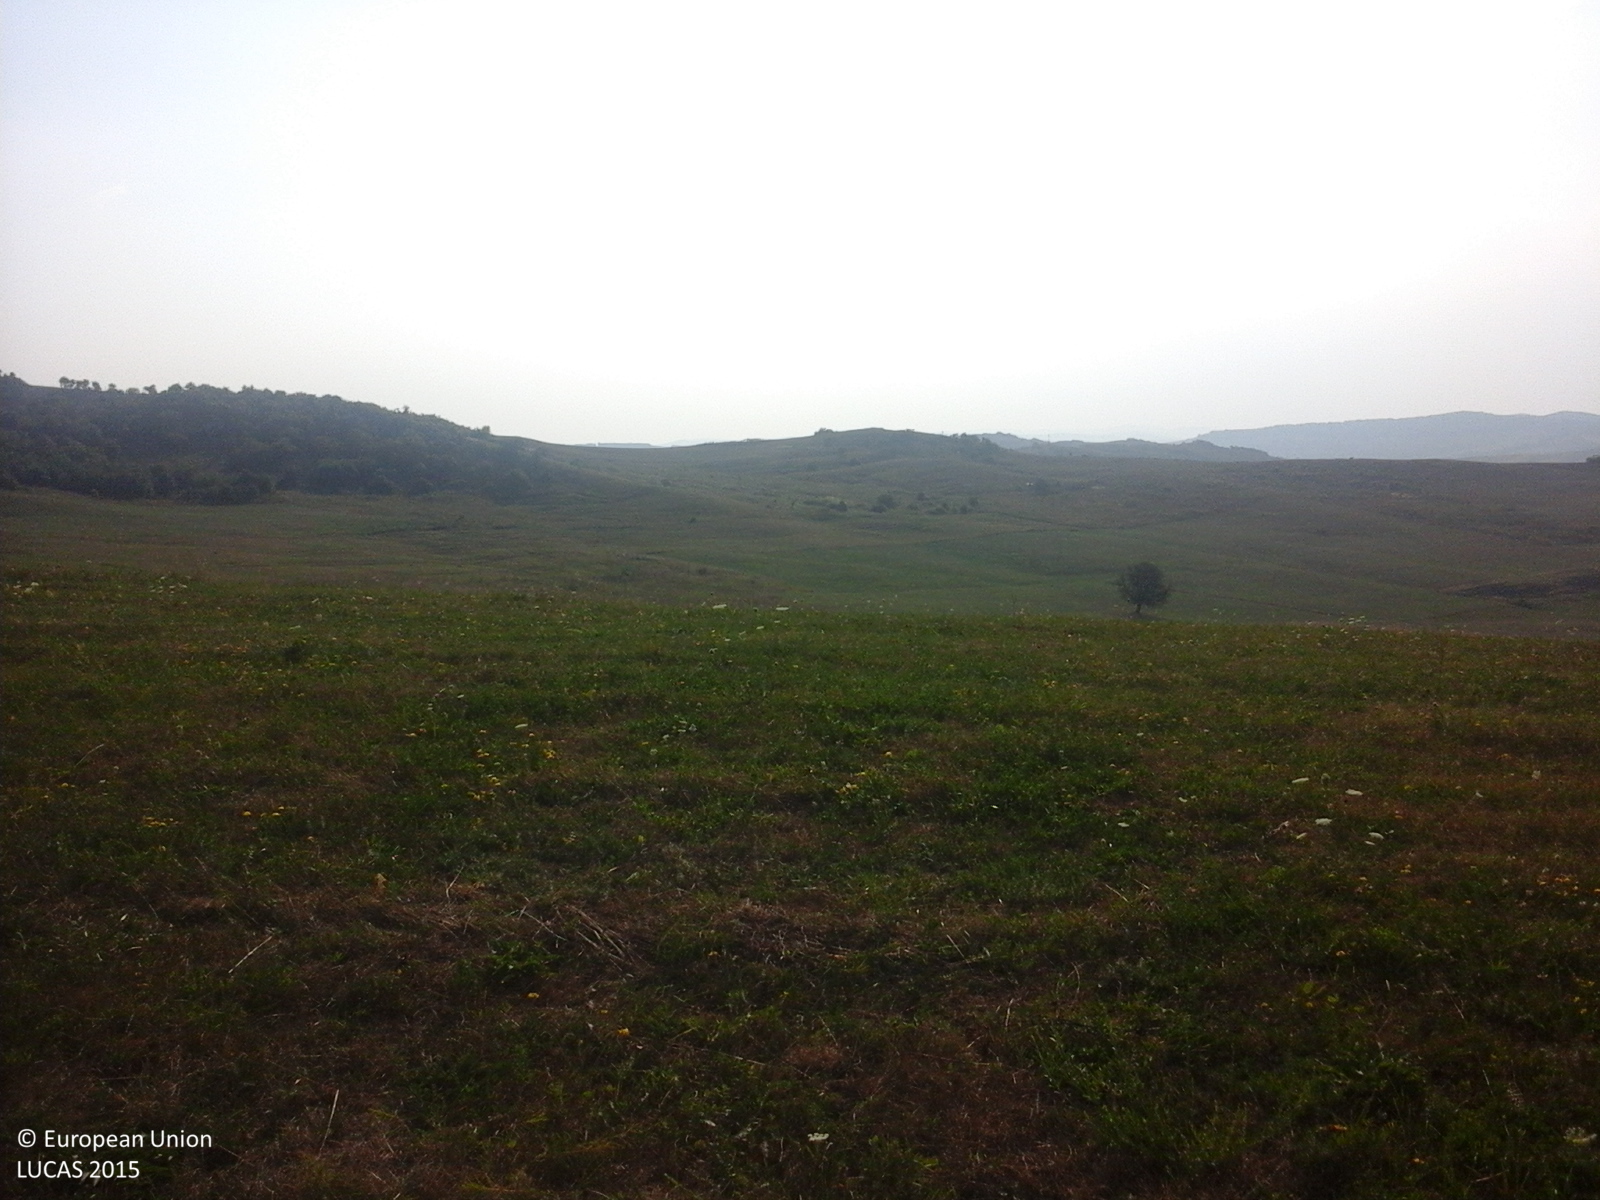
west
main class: Grassland
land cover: Grassland without tree/shrub cover
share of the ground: > 75 %
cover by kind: herbaceous plants 100 %
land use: Agriculture (excluding fallow land and kitchen gardens)
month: September
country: RO
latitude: 47.1796
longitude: 24.4063
